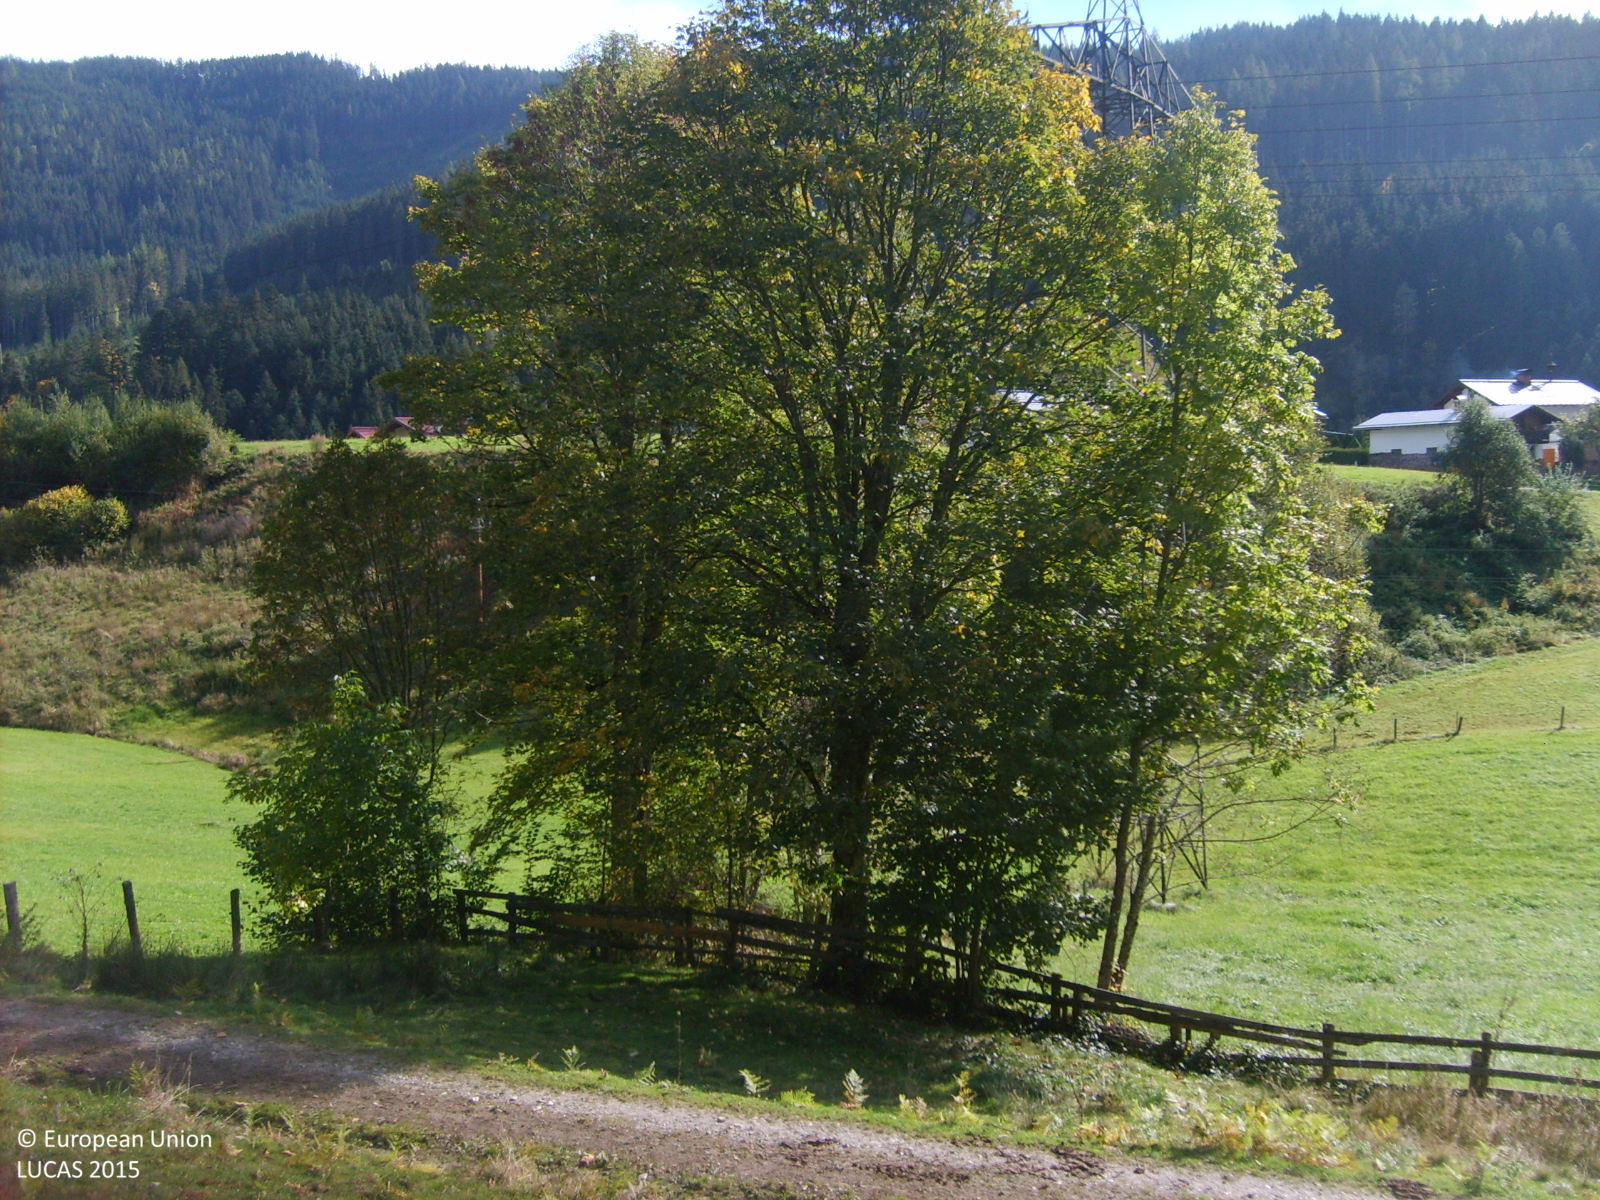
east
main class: Grassland
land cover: Grassland without tree/shrub cover
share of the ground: > 75 %
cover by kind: herbaceous plants 95 %, shrubs 5 %
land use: Agriculture (excluding fallow land and kitchen gardens)
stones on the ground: 10 - 25 %
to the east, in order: Grassland without tree/shrub cover; Tracks; Grassland without tree/shrub cover; Fences; Broadleaved woodland; Grassland without tree/shrub cover; Electric lines; Grassland without tree/shrub cover; Electric lines; Grassland without tree/shrub cover; Artificial constructions in urban areas; Spruce dominated mixed woodland; Paved roads, cycling and walking lanes; Grass margins; Single bushes/trees; Dry stone walls; Paved roads, cycling and walking lanes; Grass margins
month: September
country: AT
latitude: 47.4340
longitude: 13.3527
